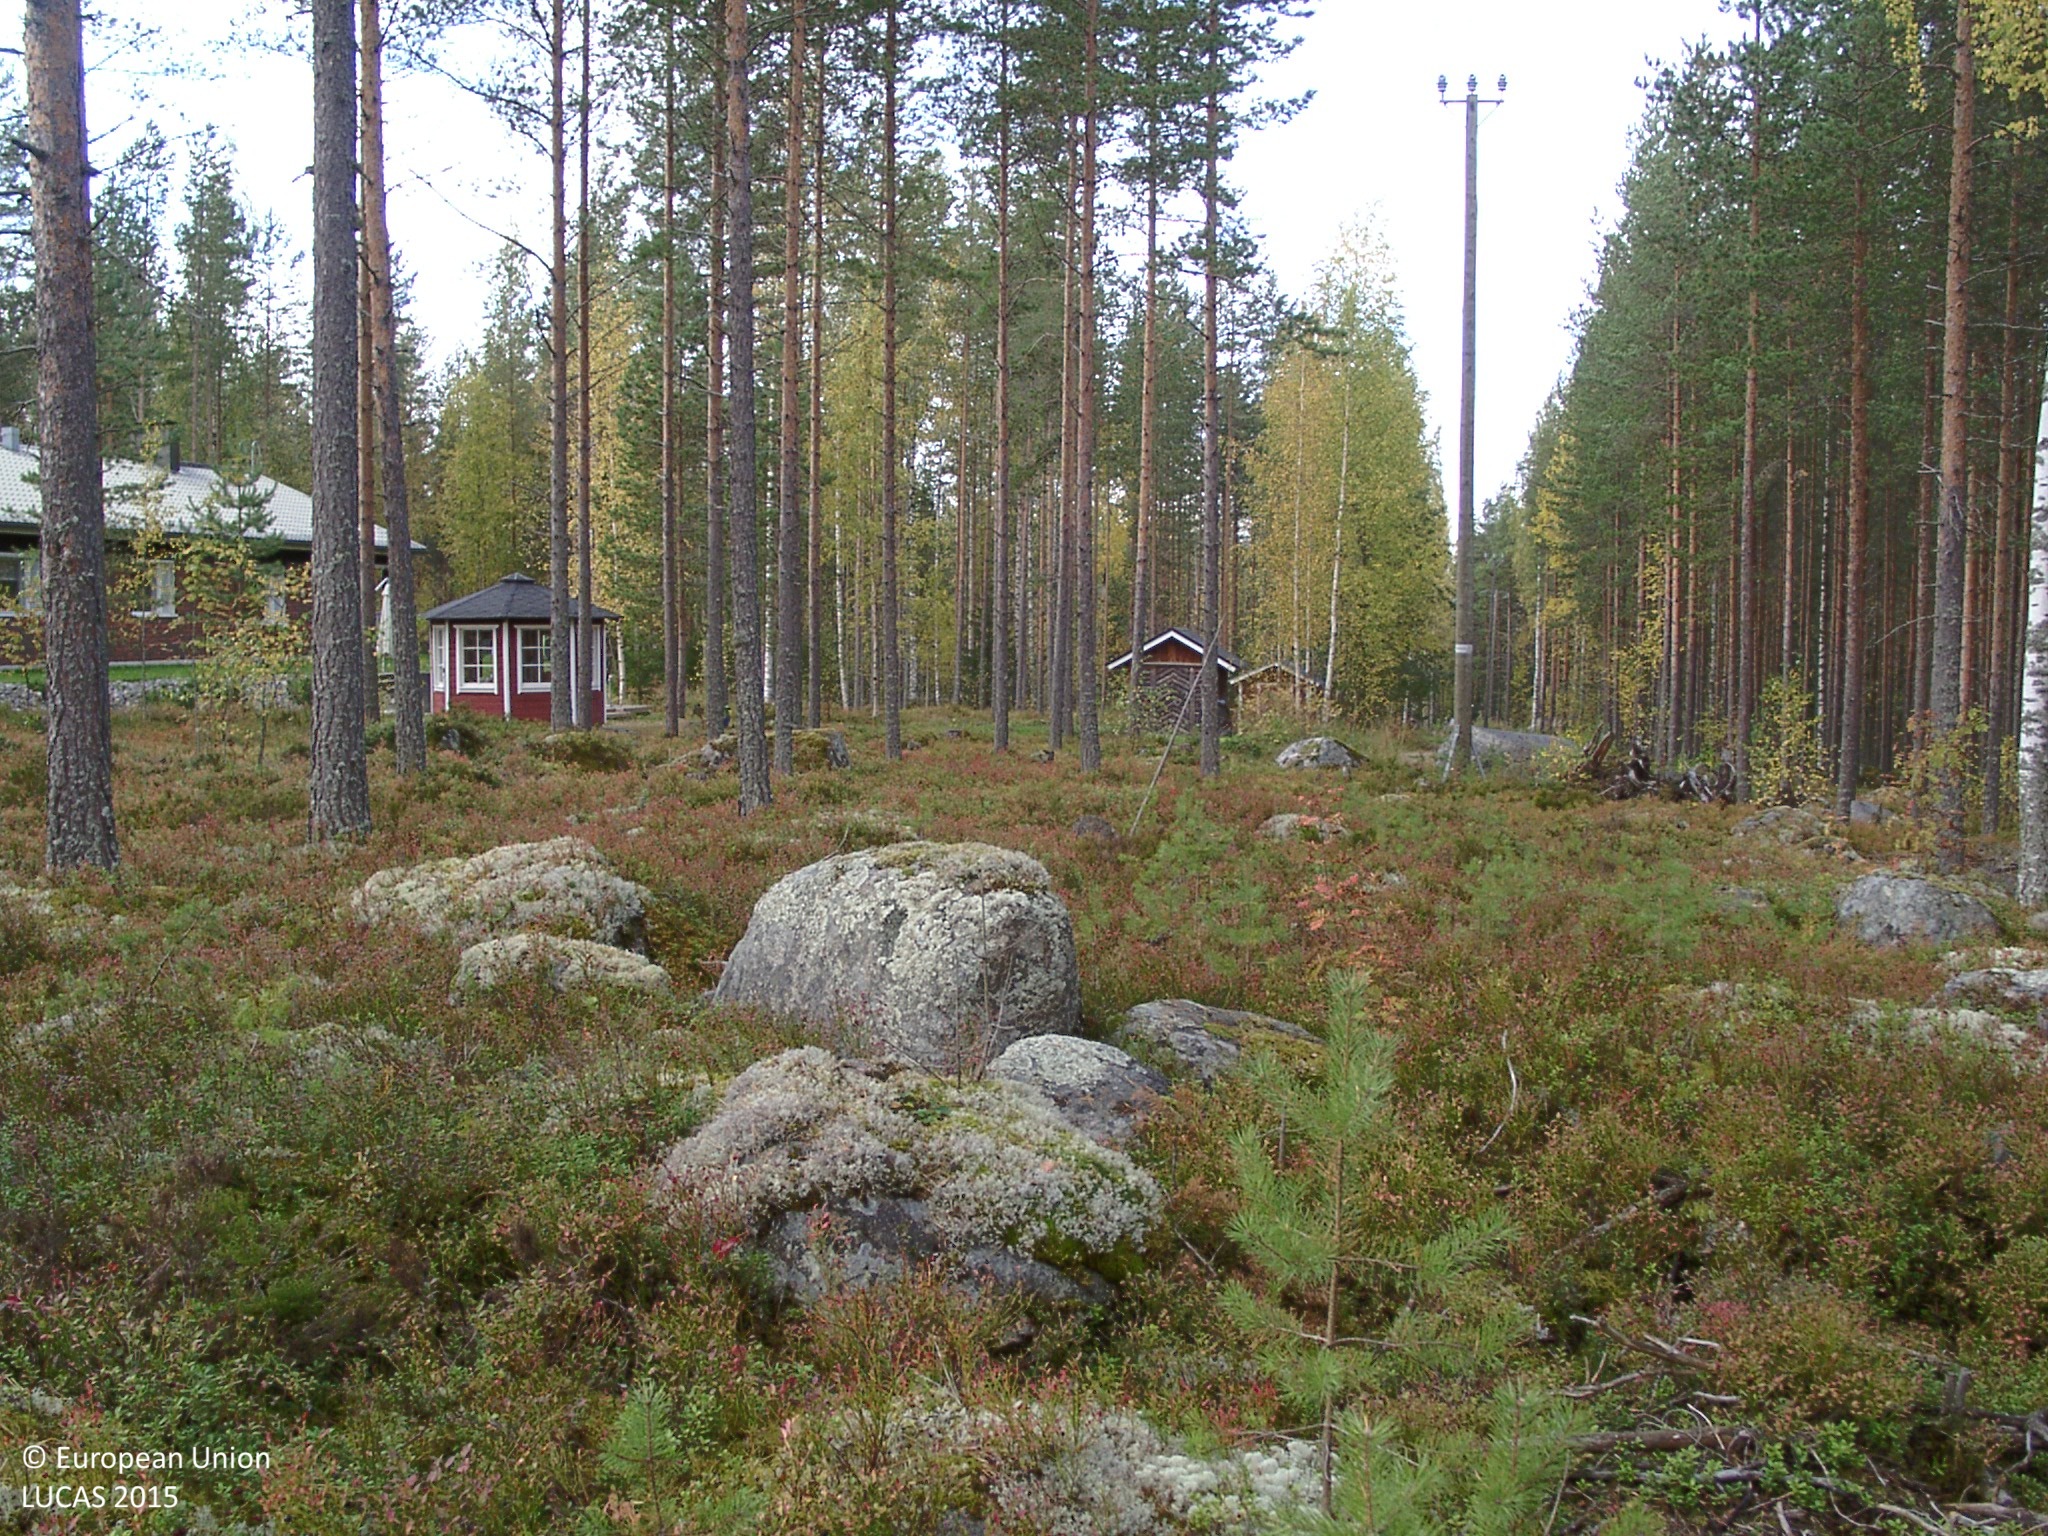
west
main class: Shrubland
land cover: Shrubland without tree cover
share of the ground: > 75 %
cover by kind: shrubs 80 %, lichens and mosses 20 %
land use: Electricity, gas and thermal power distribution
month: September
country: FI
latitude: 62.6837
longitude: 25.3618
